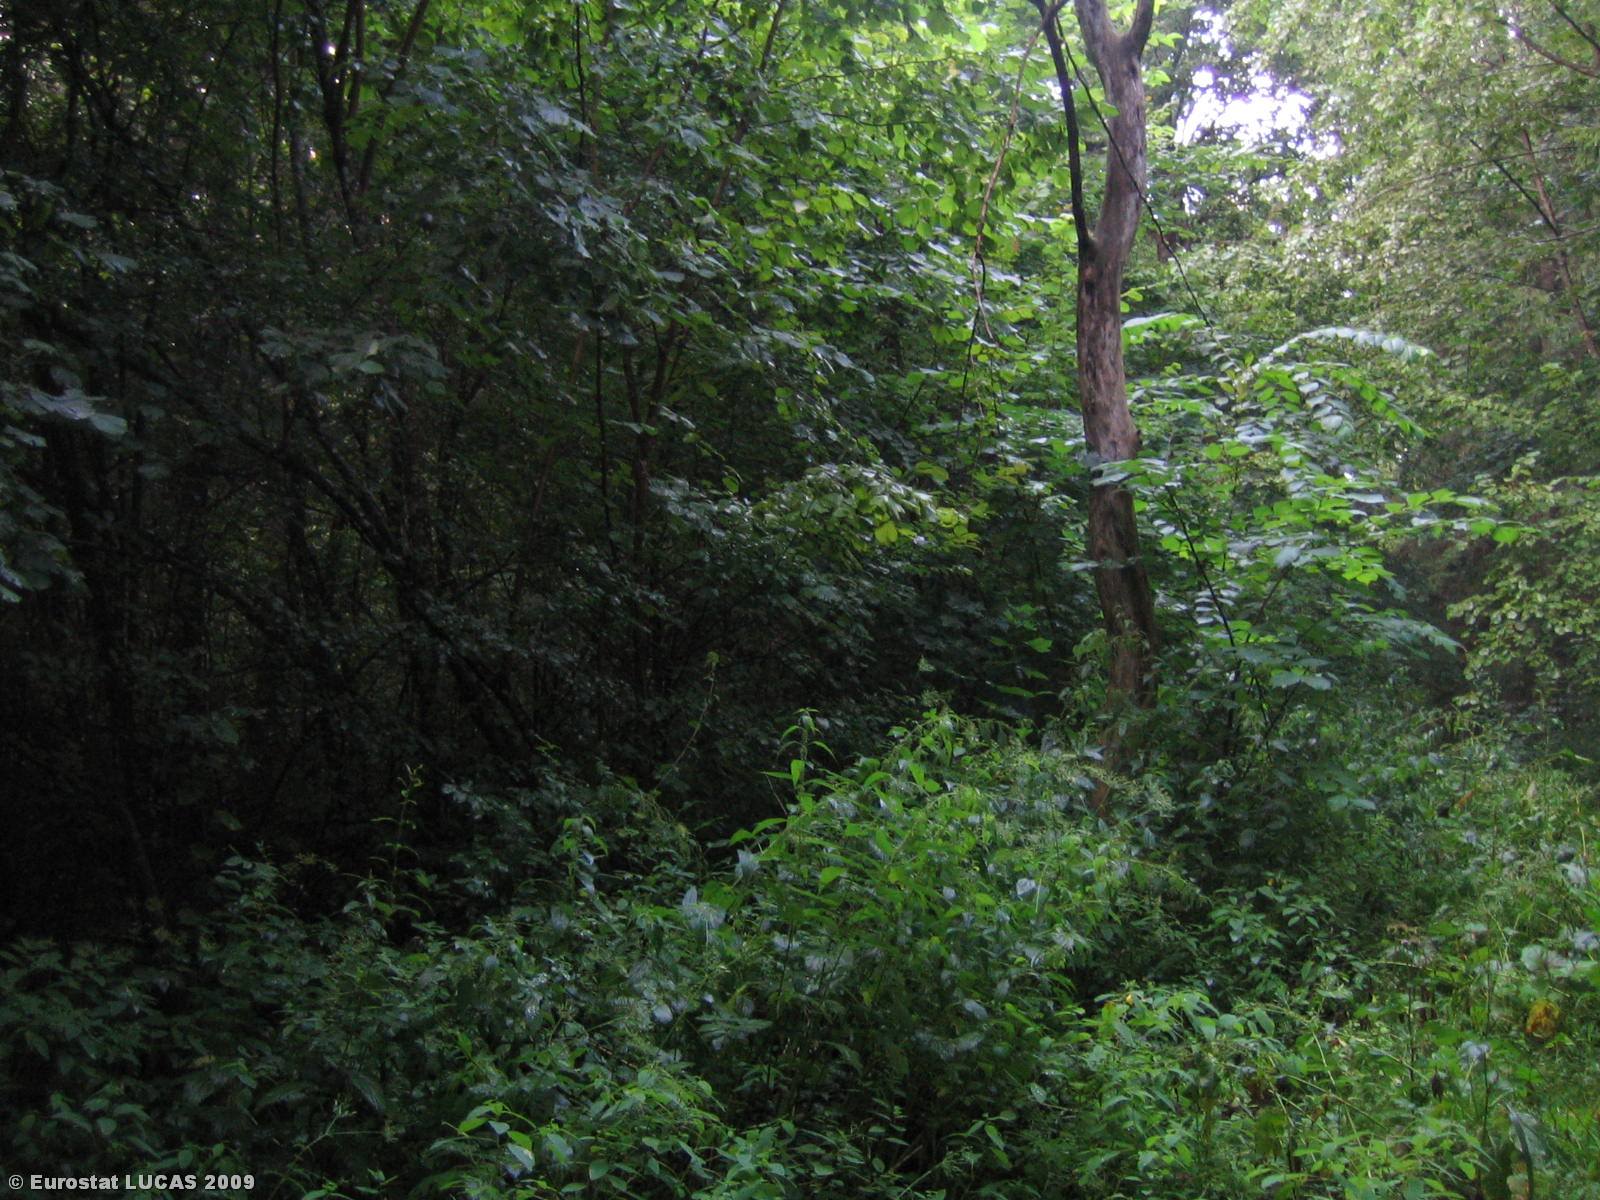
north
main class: Woodland
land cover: Mixed woodland
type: hemiboreal forest and nemoral coniferous forest and mixed broadleaved-coniferous forest
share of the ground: > 75 %
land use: Forestry
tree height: > 5 m
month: August
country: LT
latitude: 54.6790
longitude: 24.6697
